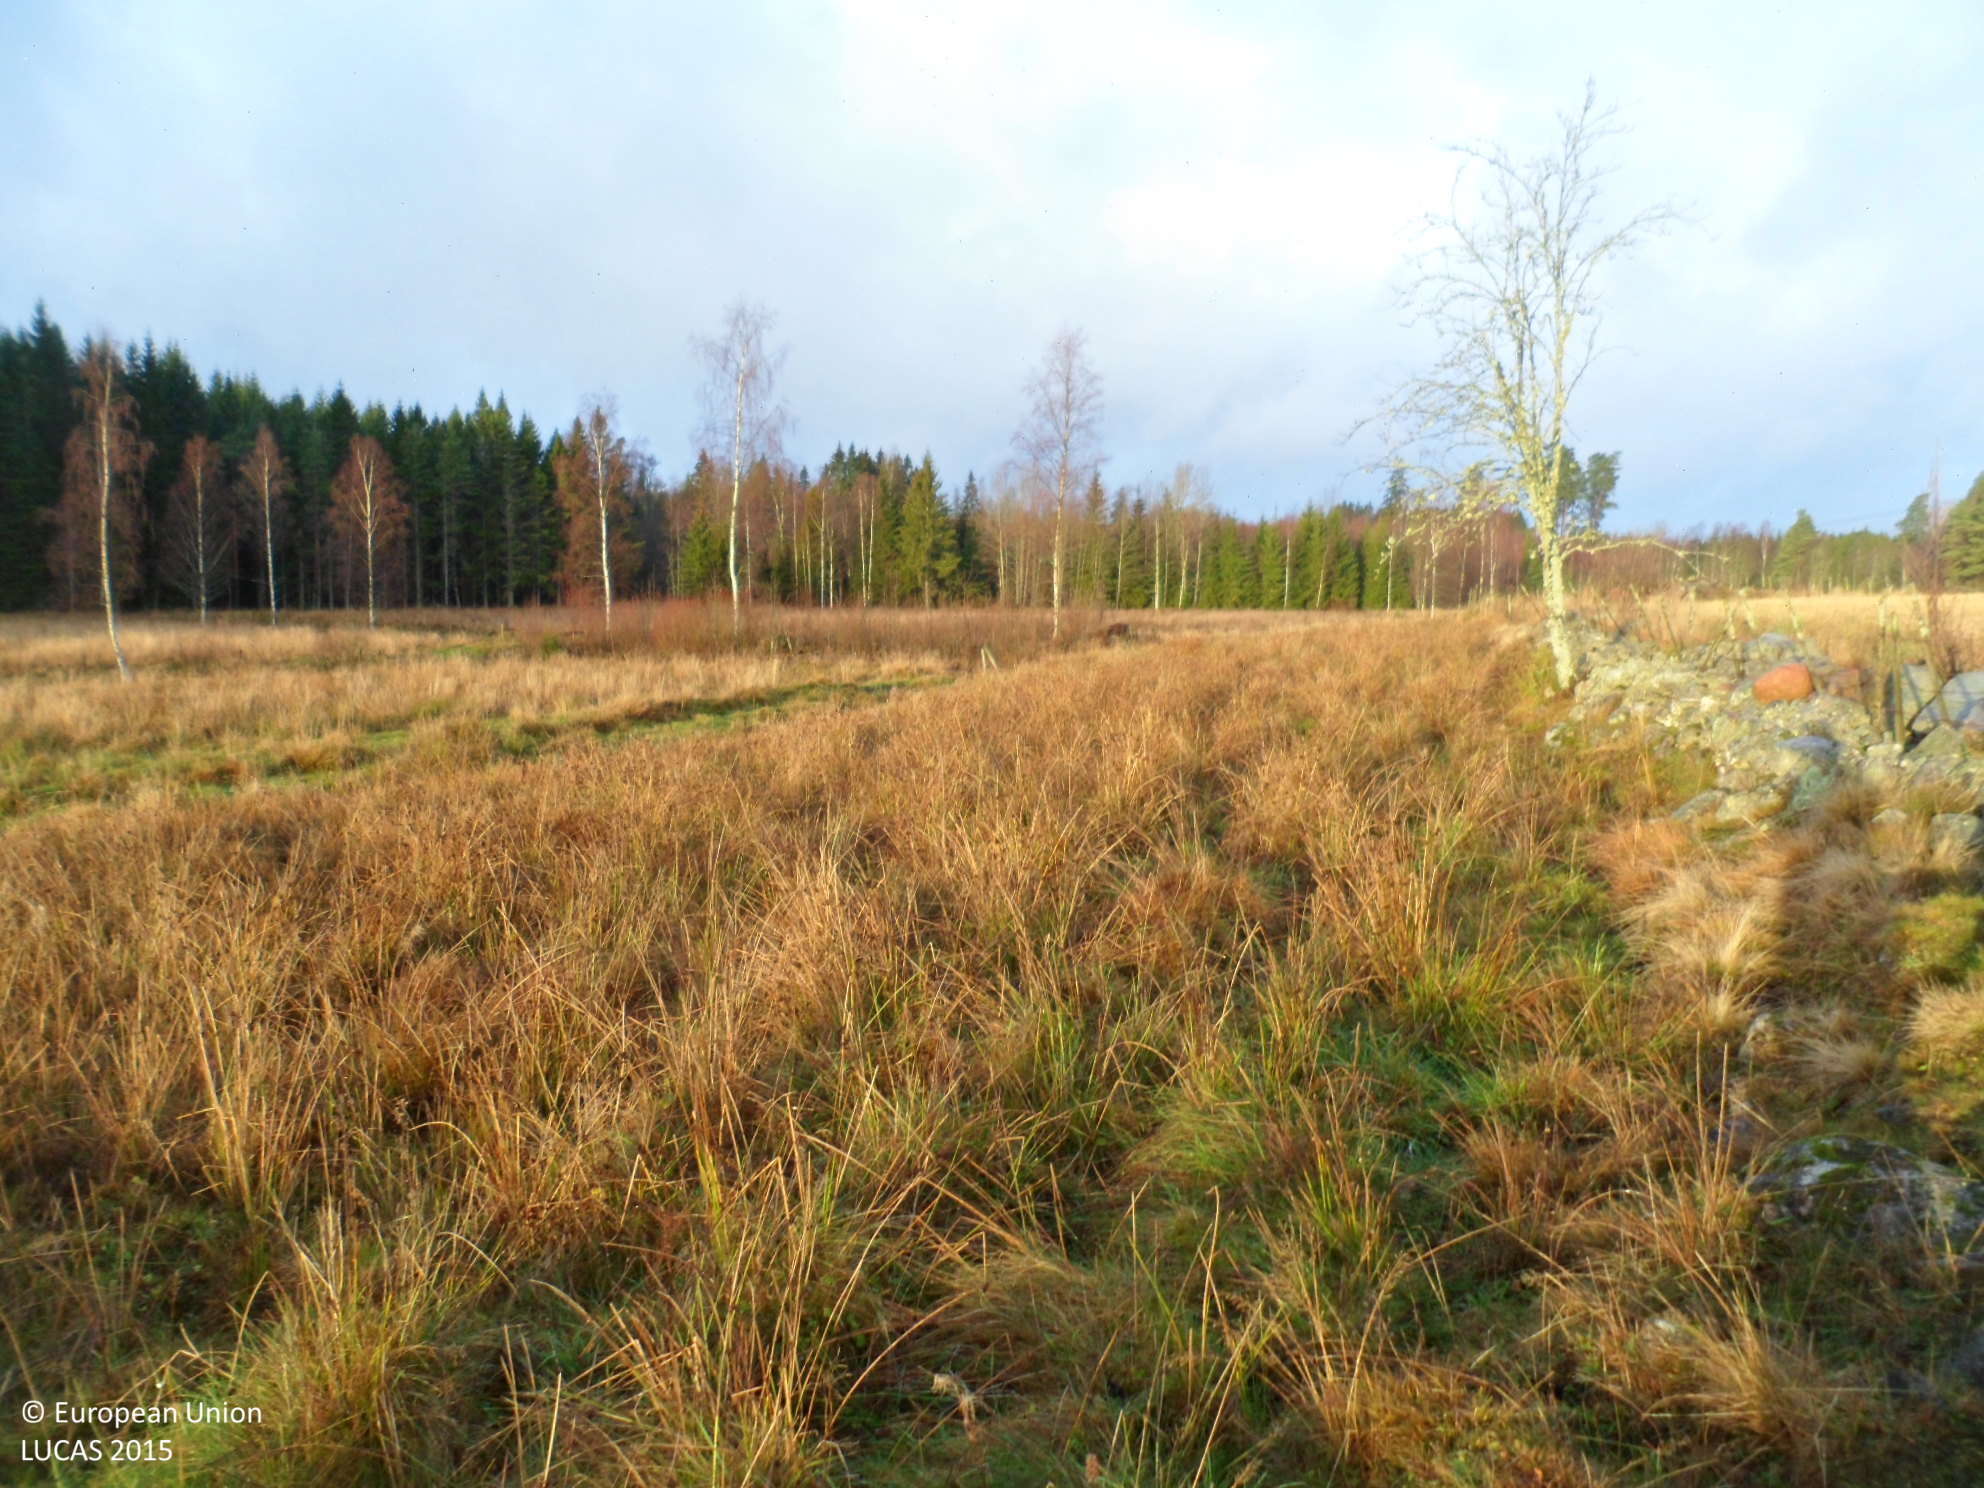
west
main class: Grassland
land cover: Grassland without tree/shrub cover
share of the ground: > 75 %
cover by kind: herbaceous plants 90 %, lichens and mosses 10 %
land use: Agriculture (excluding fallow land and kitchen gardens)
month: November
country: SE
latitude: 57.5975
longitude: 15.1662
